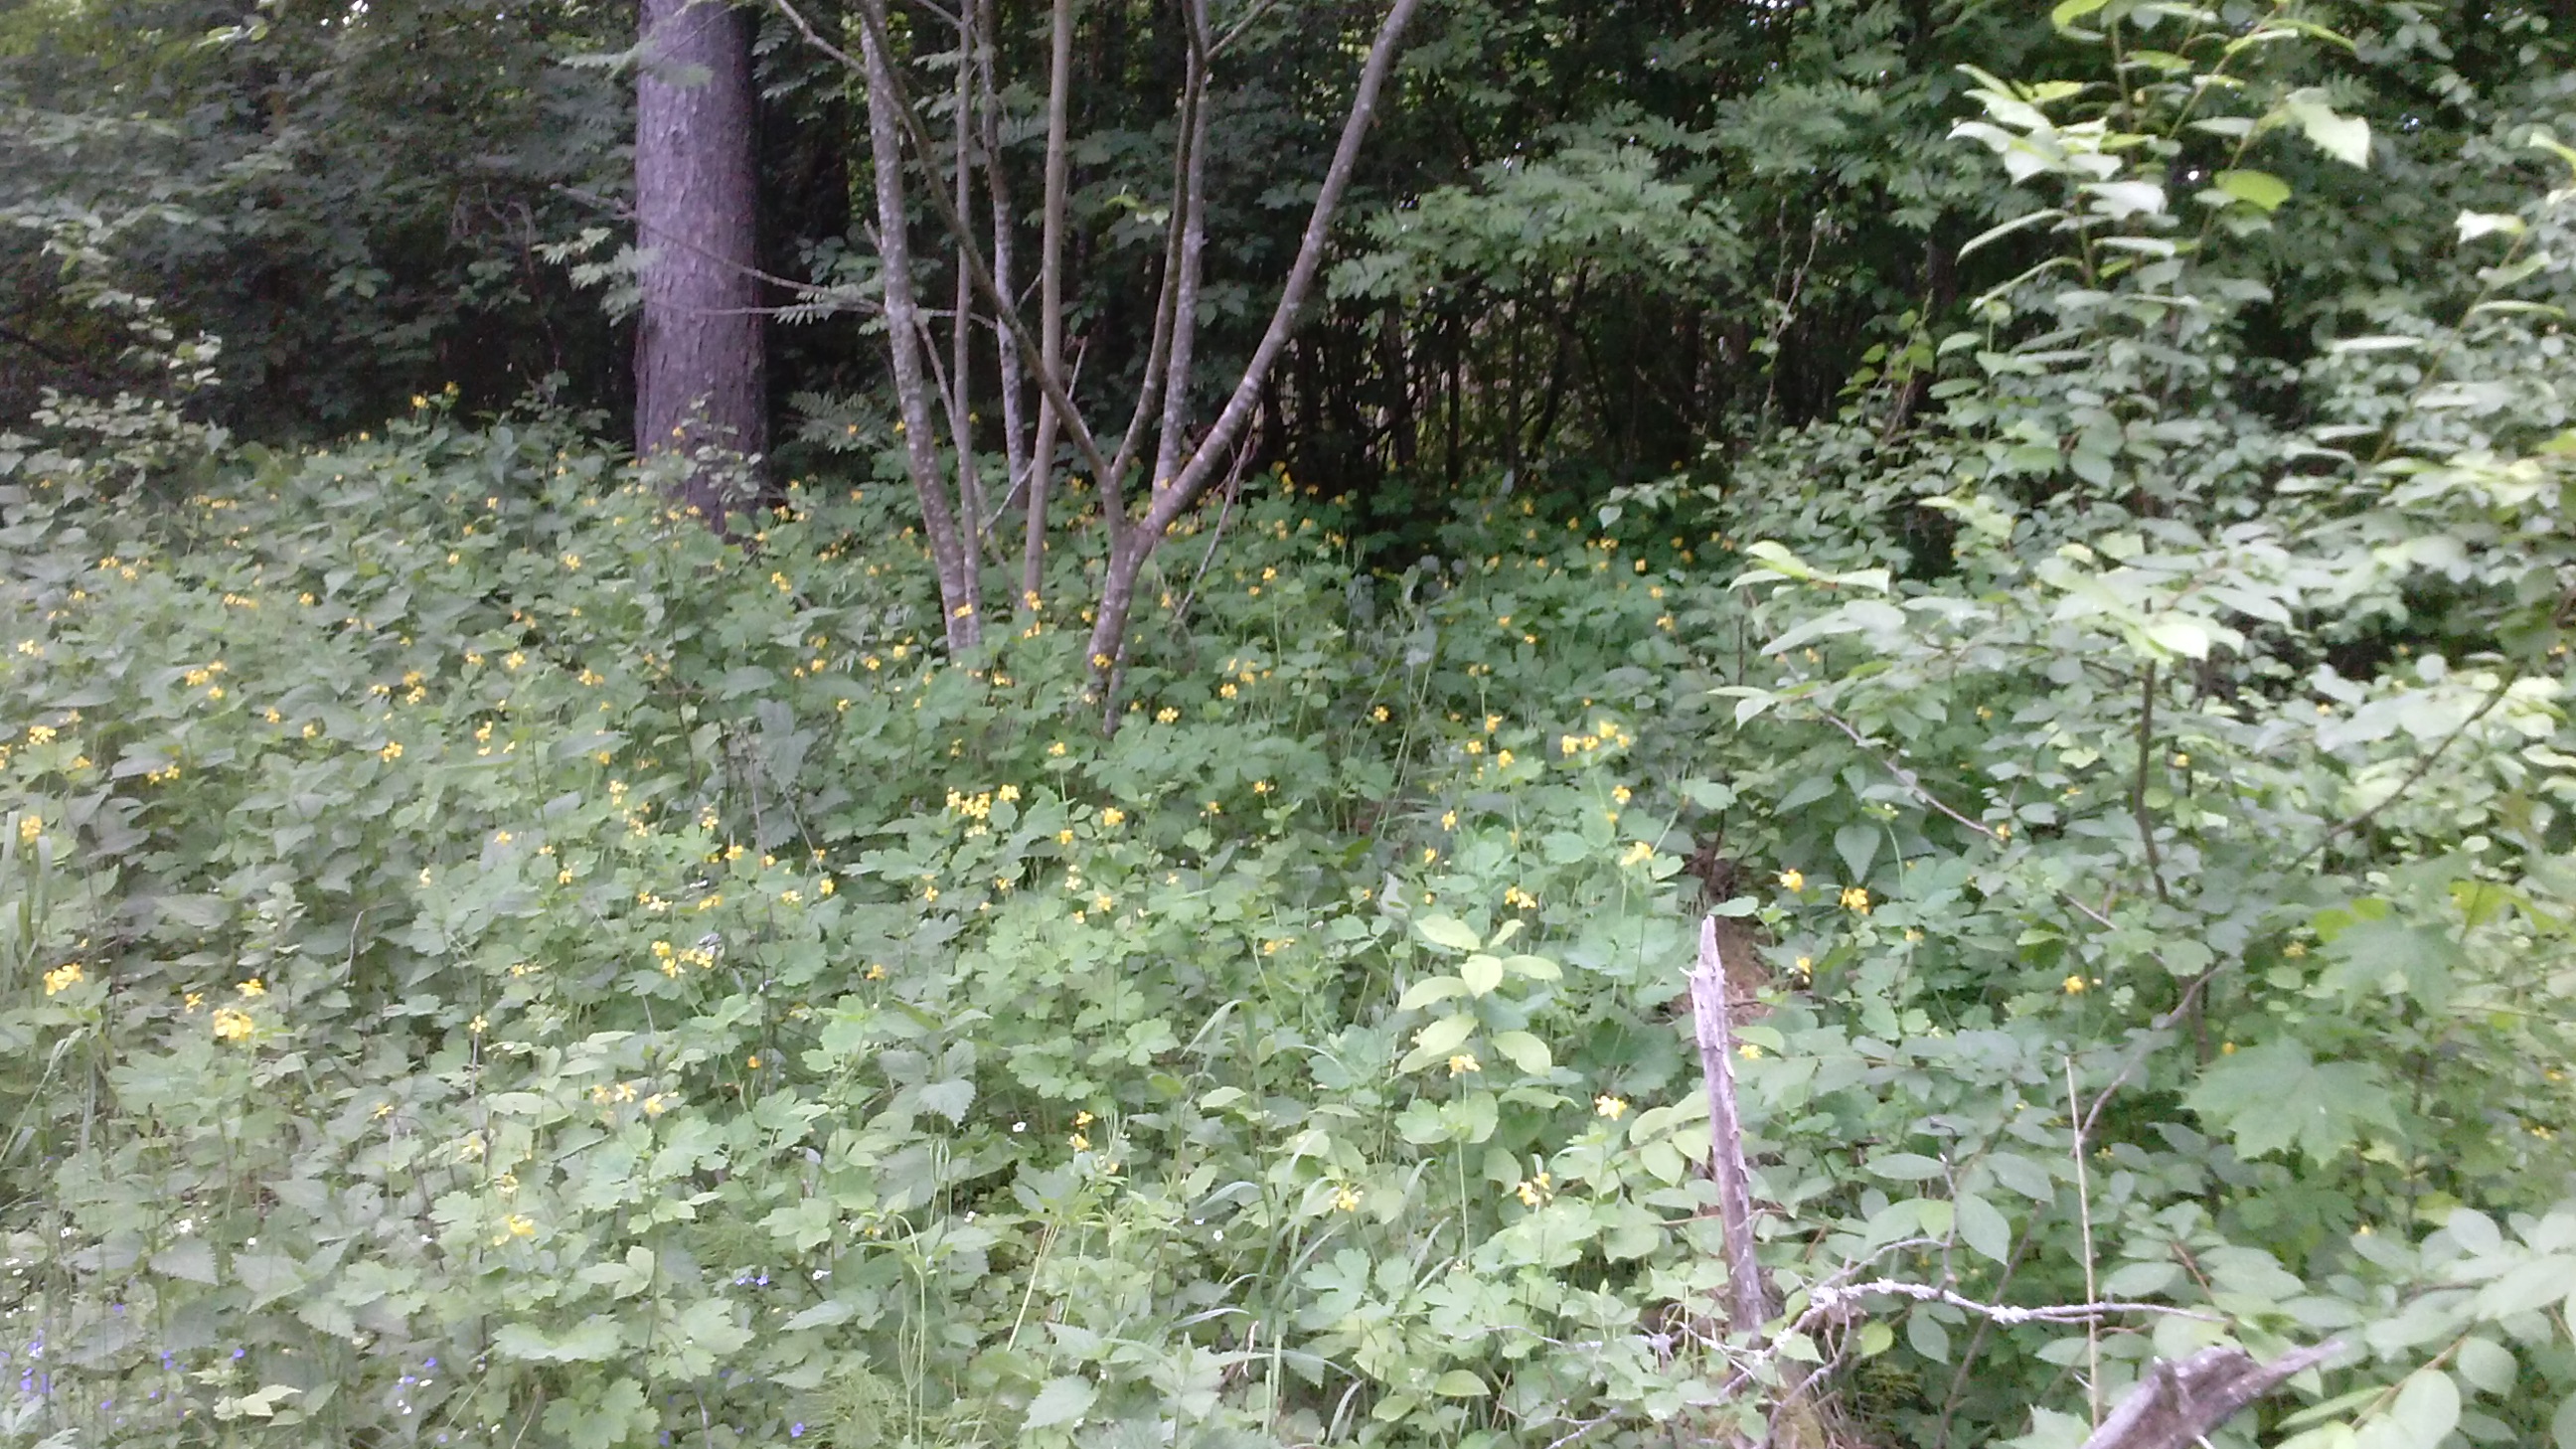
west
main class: Woodland
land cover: Broadleaved woodland
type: non-riverine alder, birch or aspen forest
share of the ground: > 75 %
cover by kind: broadleaved forest trees 70 %, coniferous forest trees 10 %, shrubs 10 %, herbaceous plants 10 %
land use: Forestry
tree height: > 5 m
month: June
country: LV
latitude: 56.1781
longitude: 28.0986
